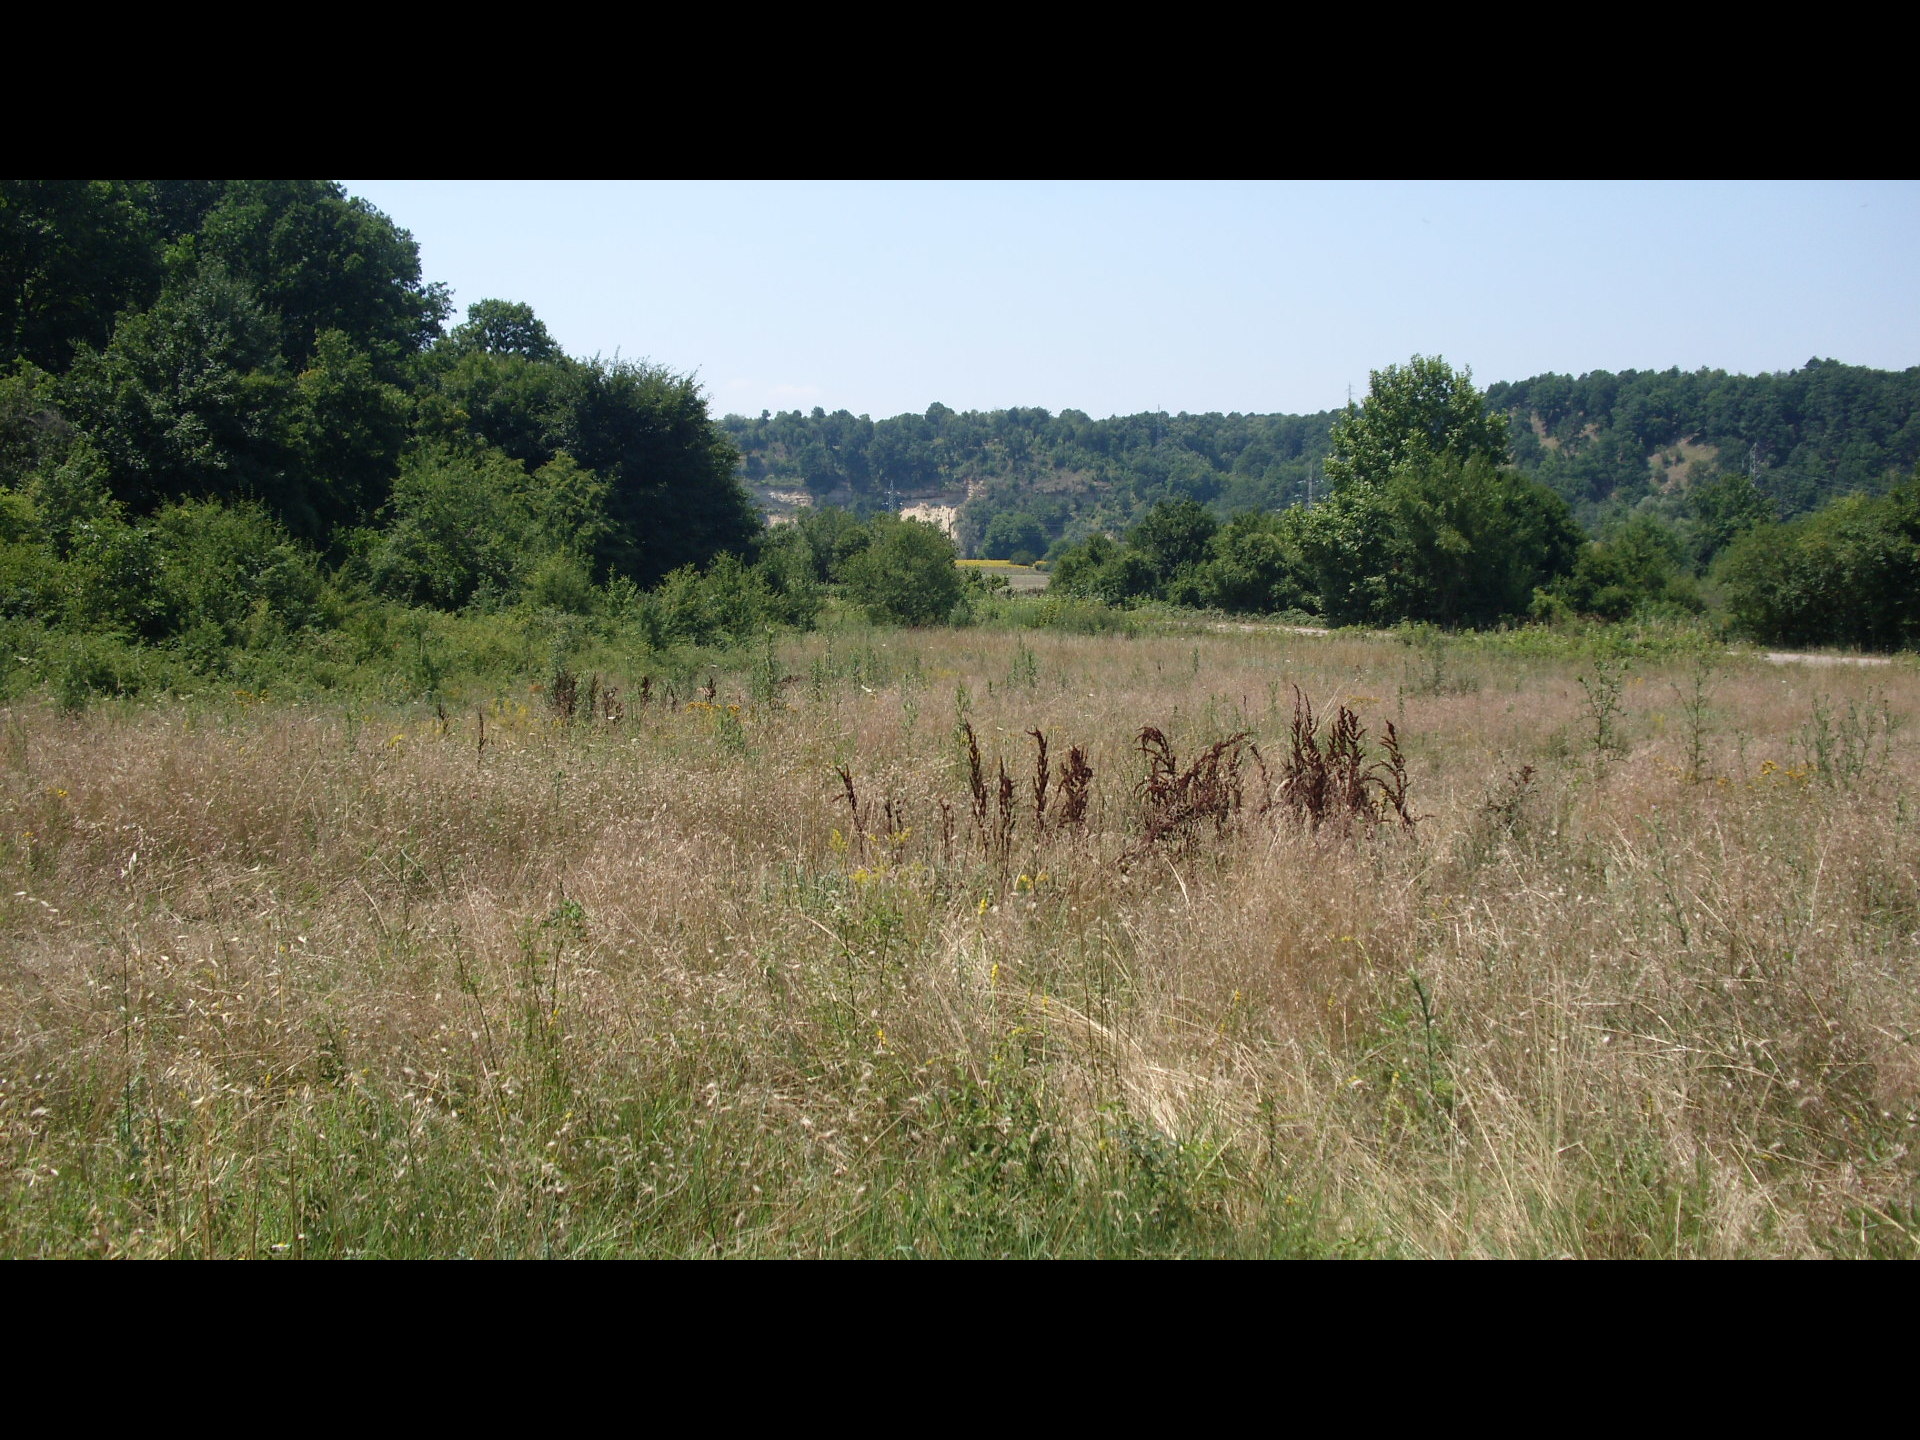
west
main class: Grassland
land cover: Grassland without tree/shrub cover
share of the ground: > 75 %
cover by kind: herbaceous plants 95 %, shrubs 5 %
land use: Abandoned areas
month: July
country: BG
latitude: 43.7296
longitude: 22.7104
